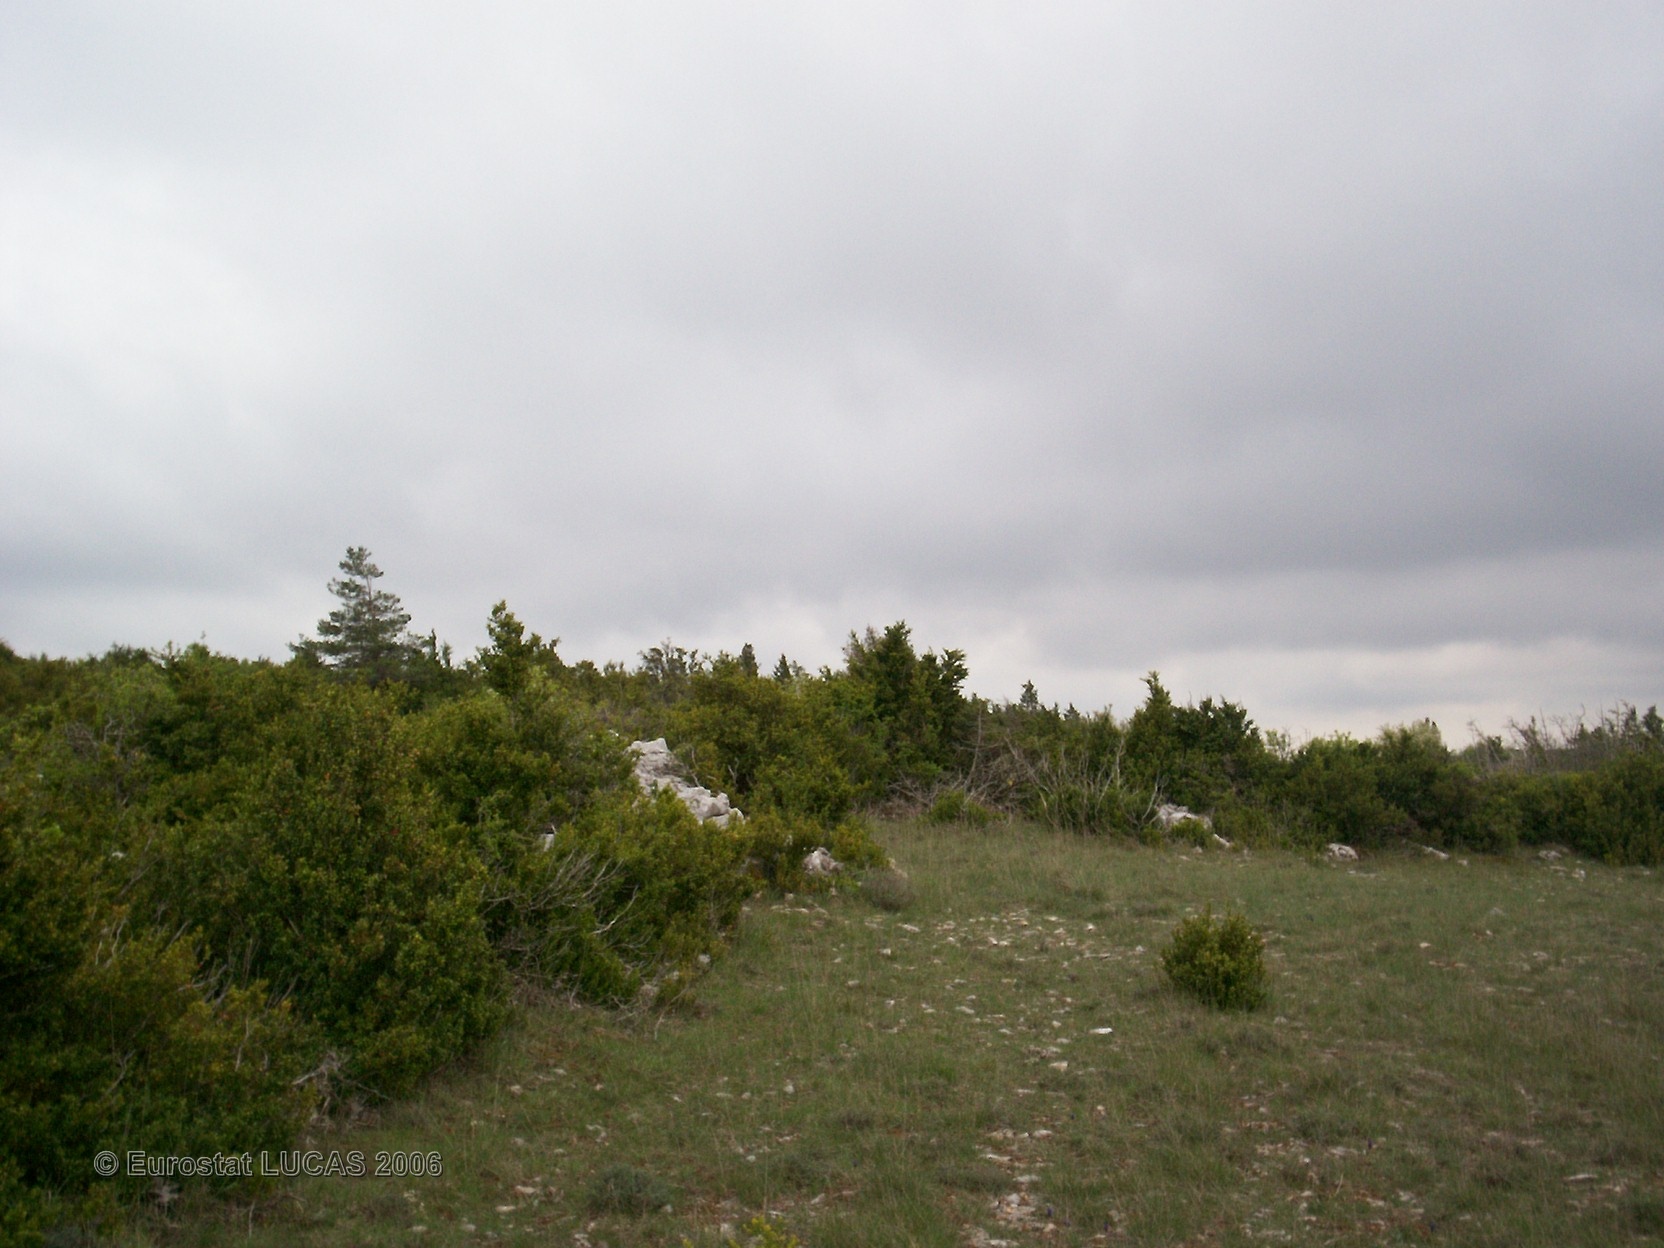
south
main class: Grassland
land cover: Grassland with sparse tree/shrub cover
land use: Agriculture (excluding fallow land and kitchen gardens)
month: May
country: FR
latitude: 43.8510
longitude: 3.4021
